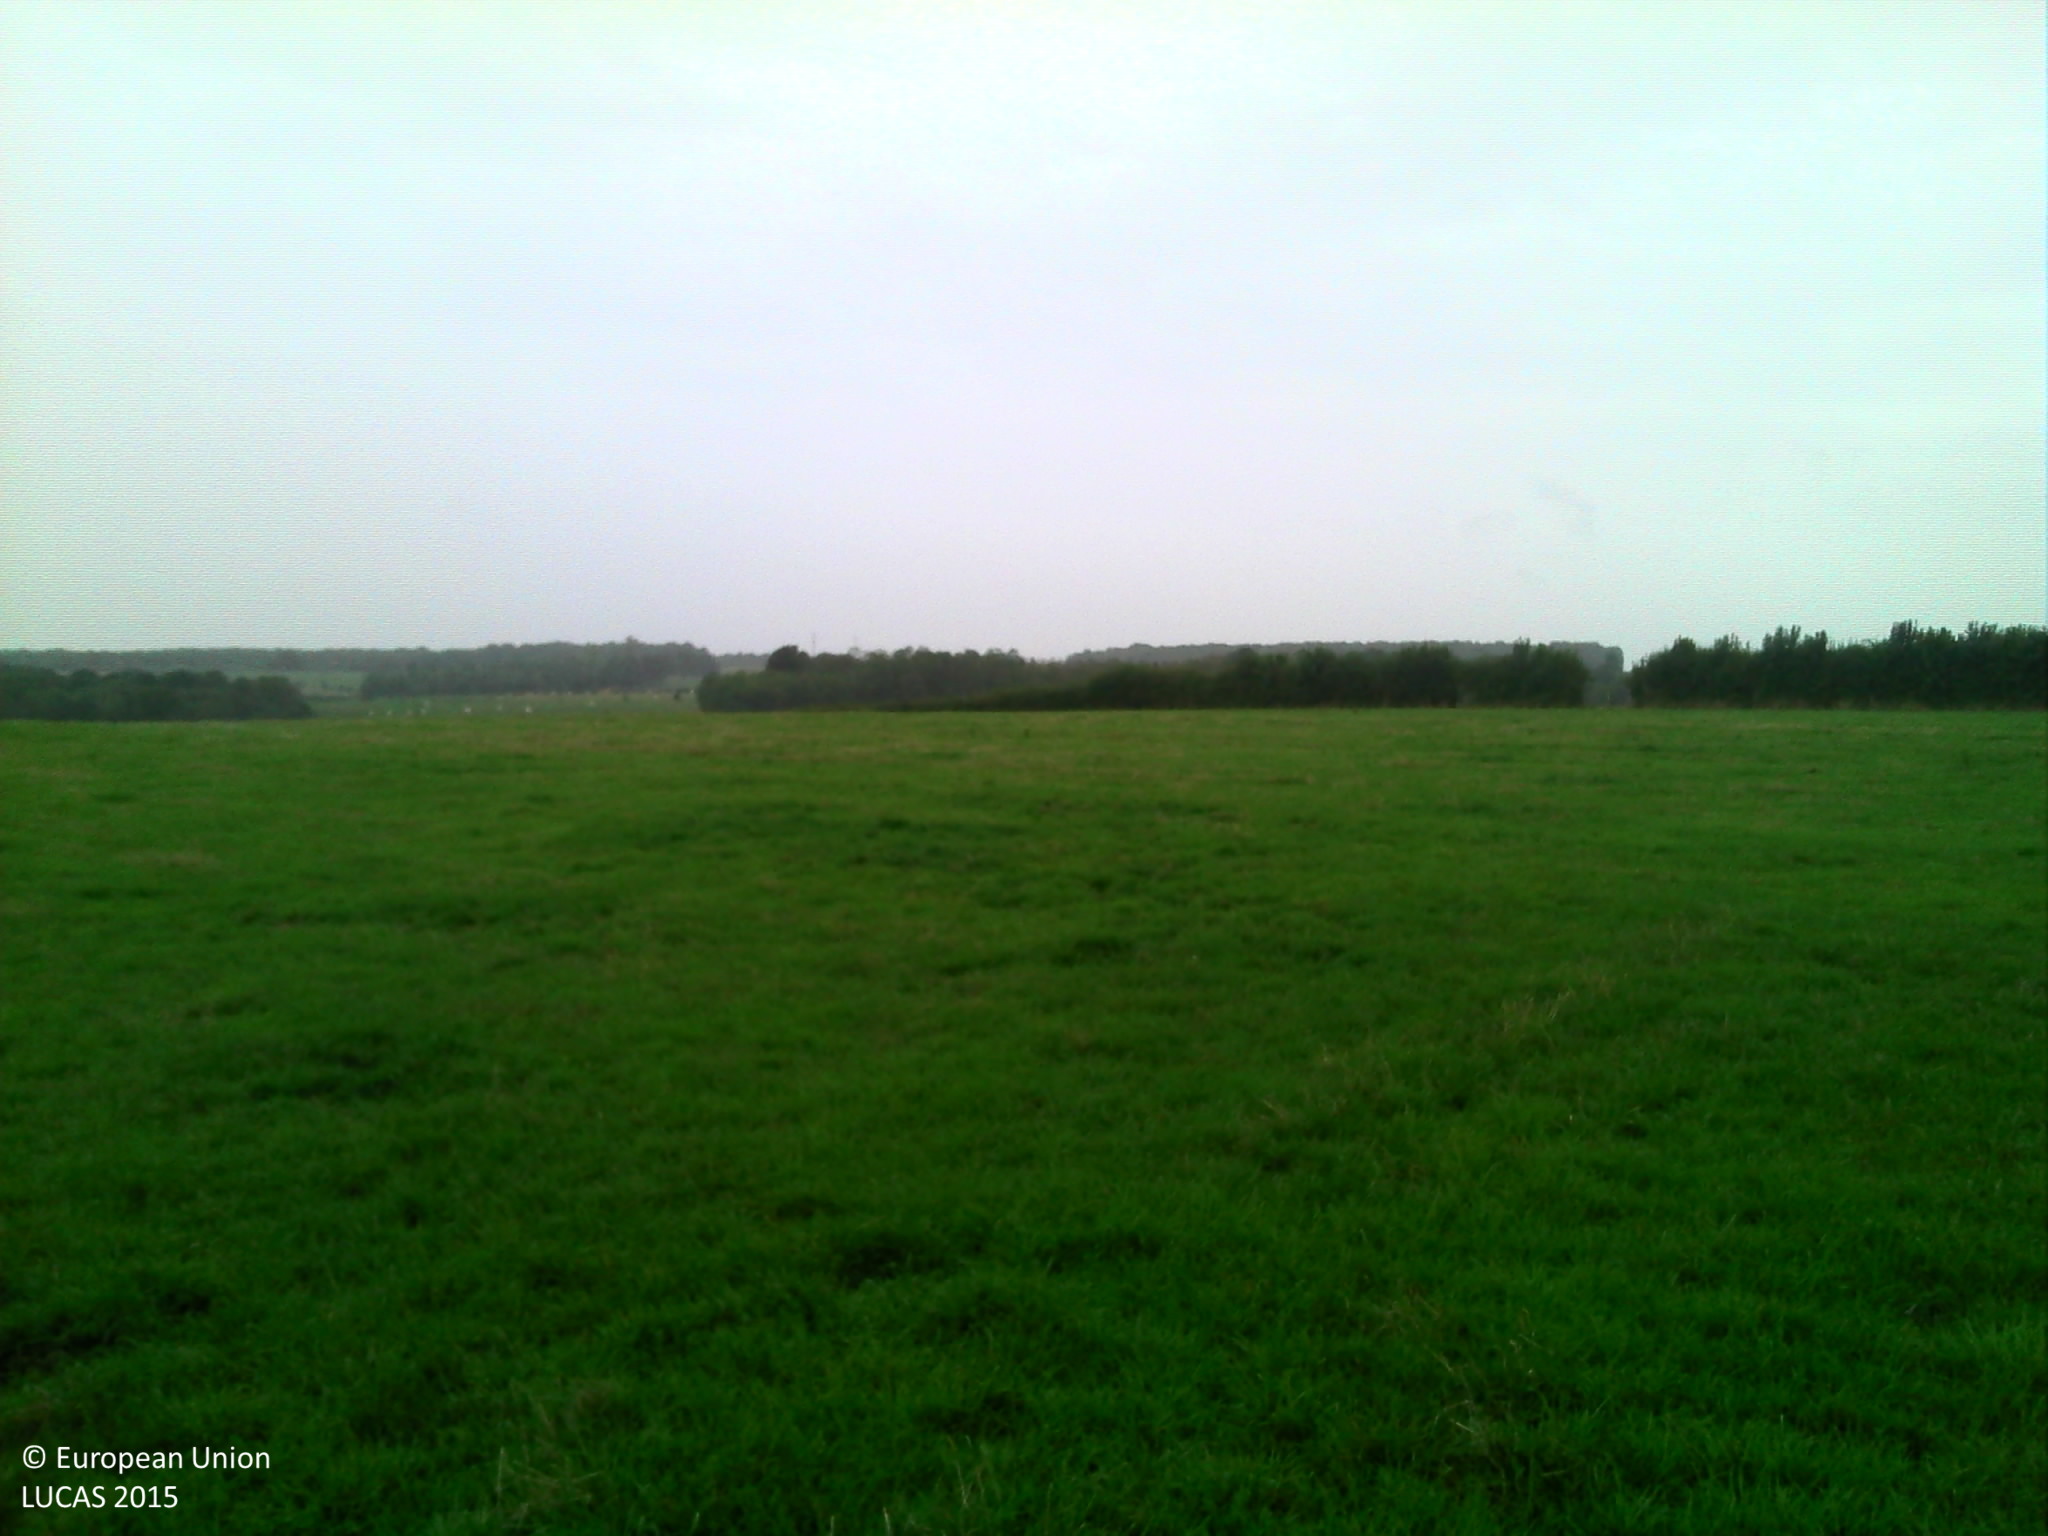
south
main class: Grassland
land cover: Grassland without tree/shrub cover
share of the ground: > 75 %
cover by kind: herbaceous plants 100 %
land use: Agriculture (excluding fallow land and kitchen gardens)
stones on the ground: < 10 %
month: September
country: FR
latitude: 47.4631
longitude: 4.3076
